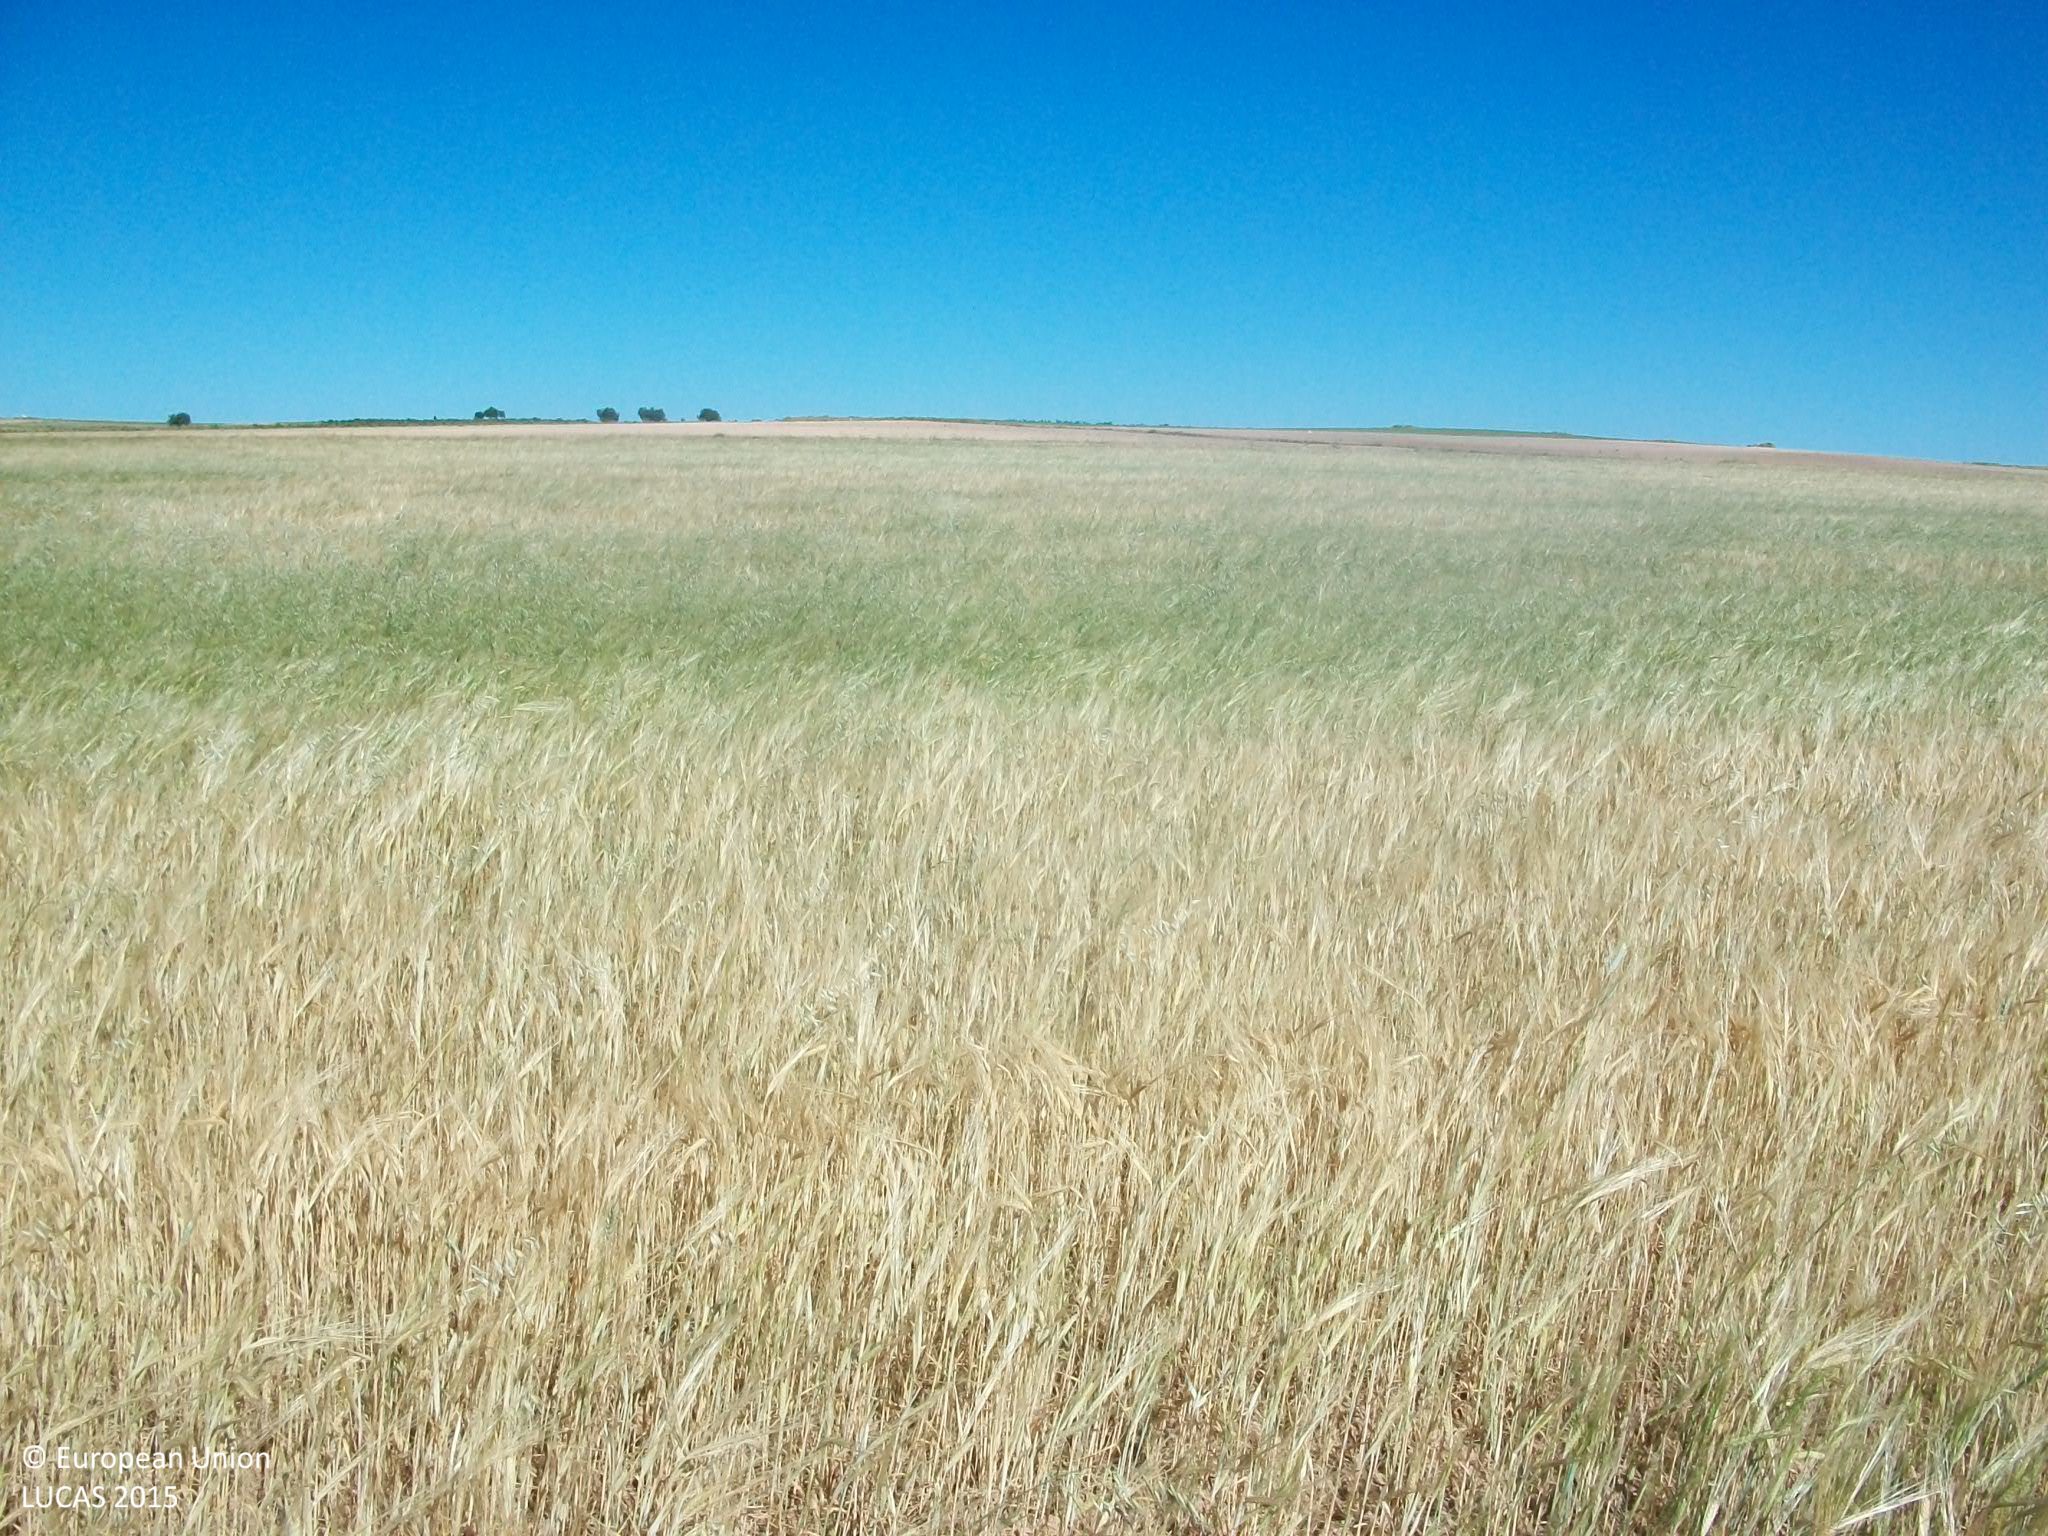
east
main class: Cropland
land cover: Barley
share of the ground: > 75 %
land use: Agriculture (excluding fallow land and kitchen gardens)
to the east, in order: Barley; Grass margins; Barley; Grass margins; Other bare soil
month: May
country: ES
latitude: 39.7774
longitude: -3.4409
